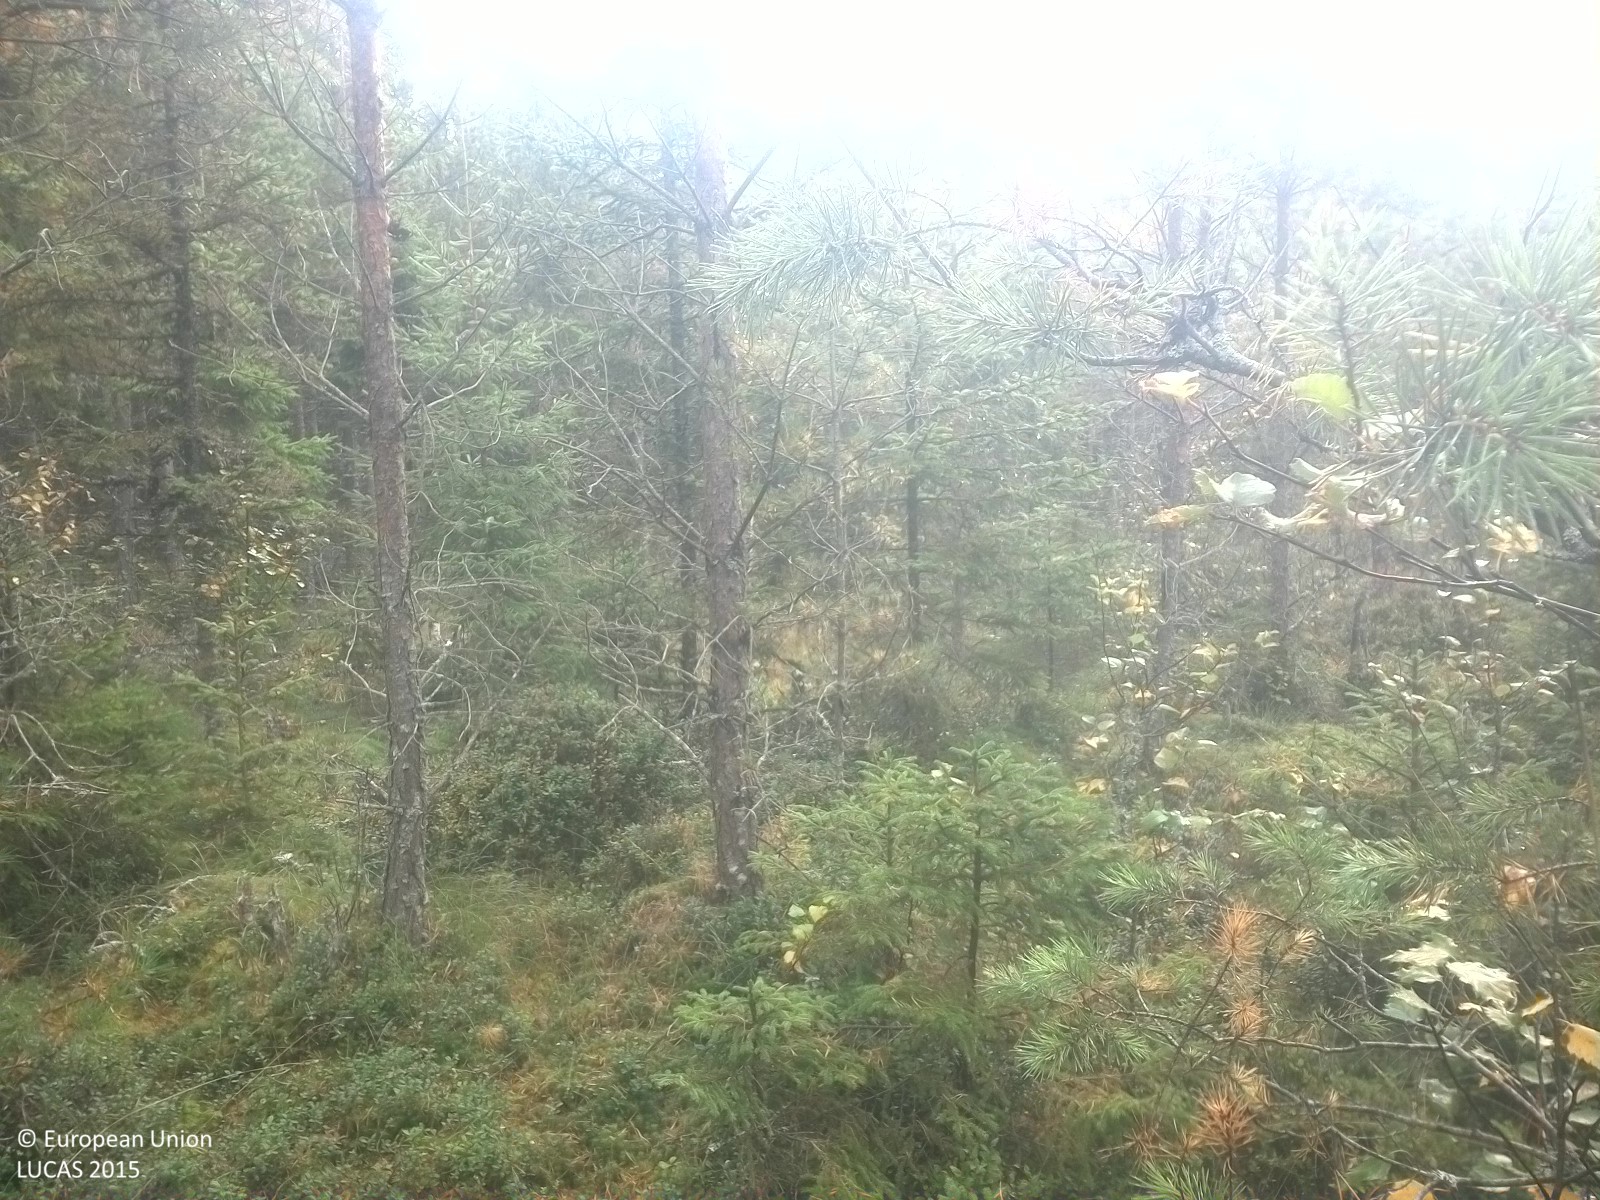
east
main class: Woodland
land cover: Pine dominated coniferous woodland
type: boreal forest
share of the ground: 25 - 50 %
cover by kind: coniferous forest trees 35 %, herbaceous plants 35 %, lichens and mosses 15 %, shrubs 10 %, broadleaved forest trees 5 %
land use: Forestry
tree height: < 5 m
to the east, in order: Pine dominated coniferous woodland; Tracks; Spruce dominated coniferous woodland; Pine dominated coniferous woodland
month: September
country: SE
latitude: 58.8593
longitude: 15.6277
